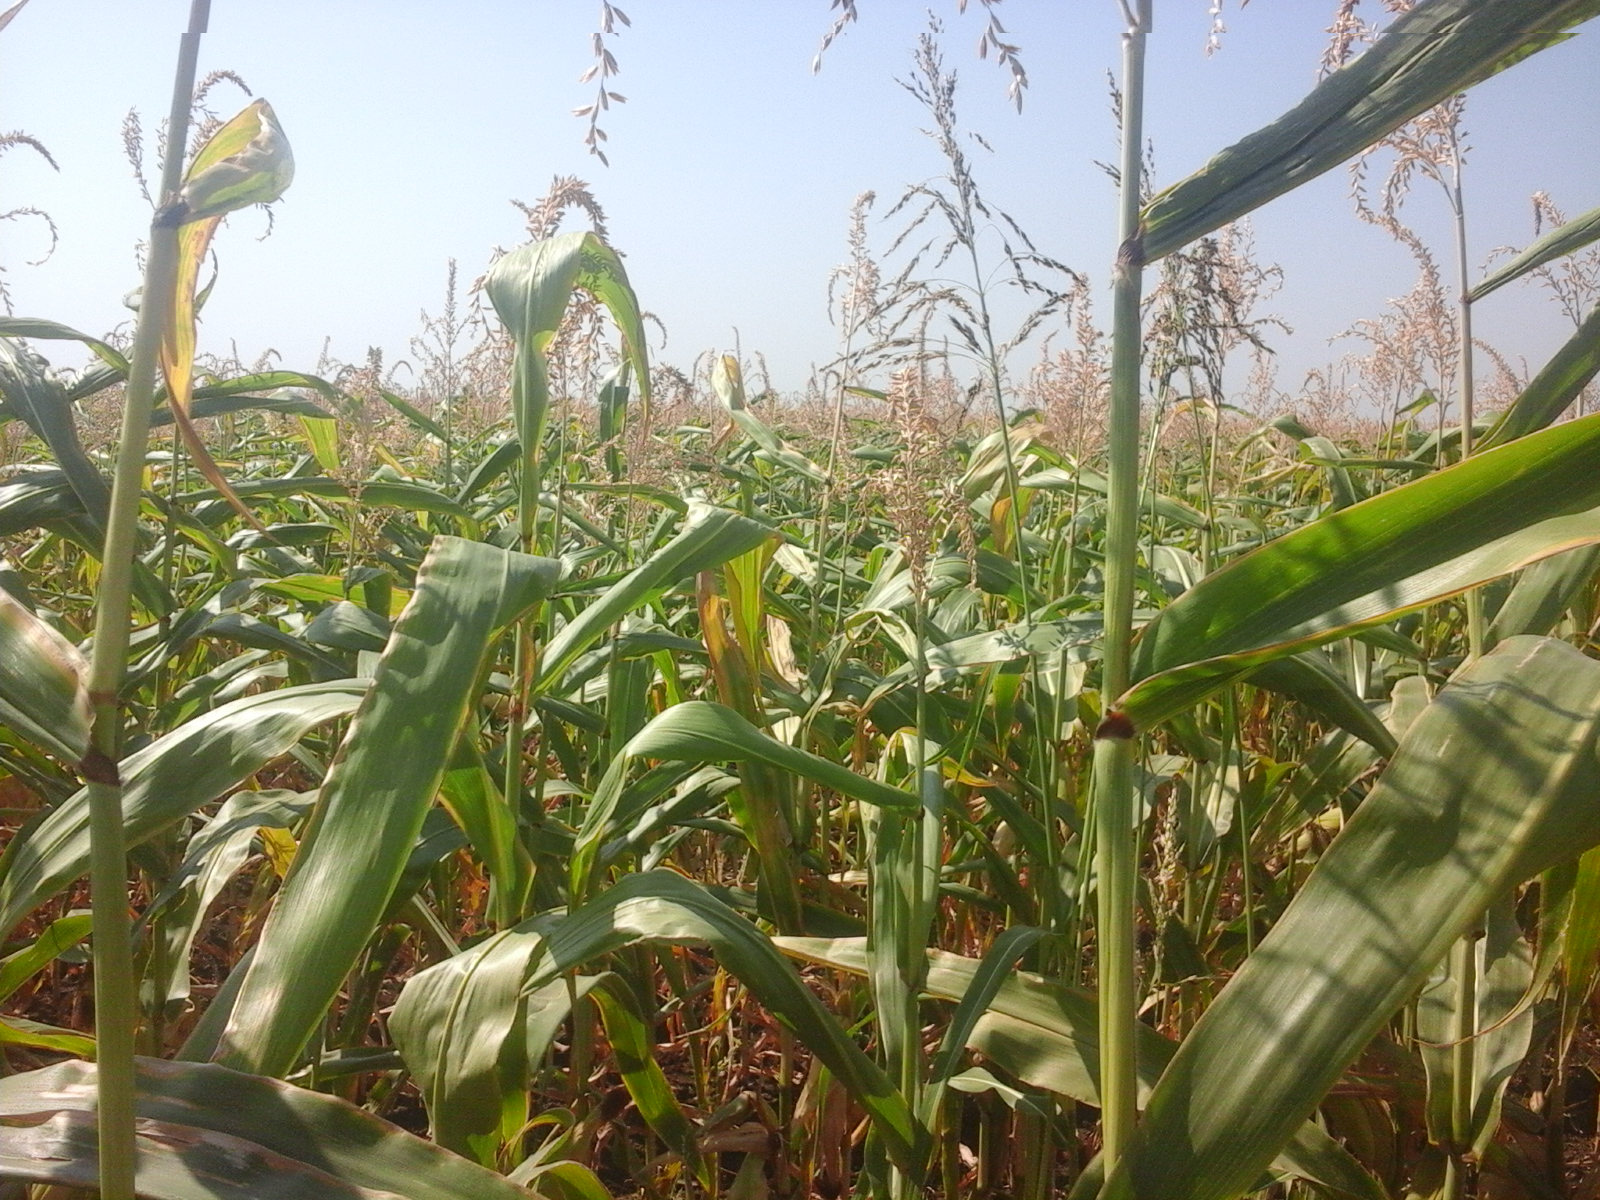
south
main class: Cropland
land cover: Maize
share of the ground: > 75 %
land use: Agriculture (excluding fallow land and kitchen gardens)
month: August
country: RO
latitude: 45.8081
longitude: 27.6486
